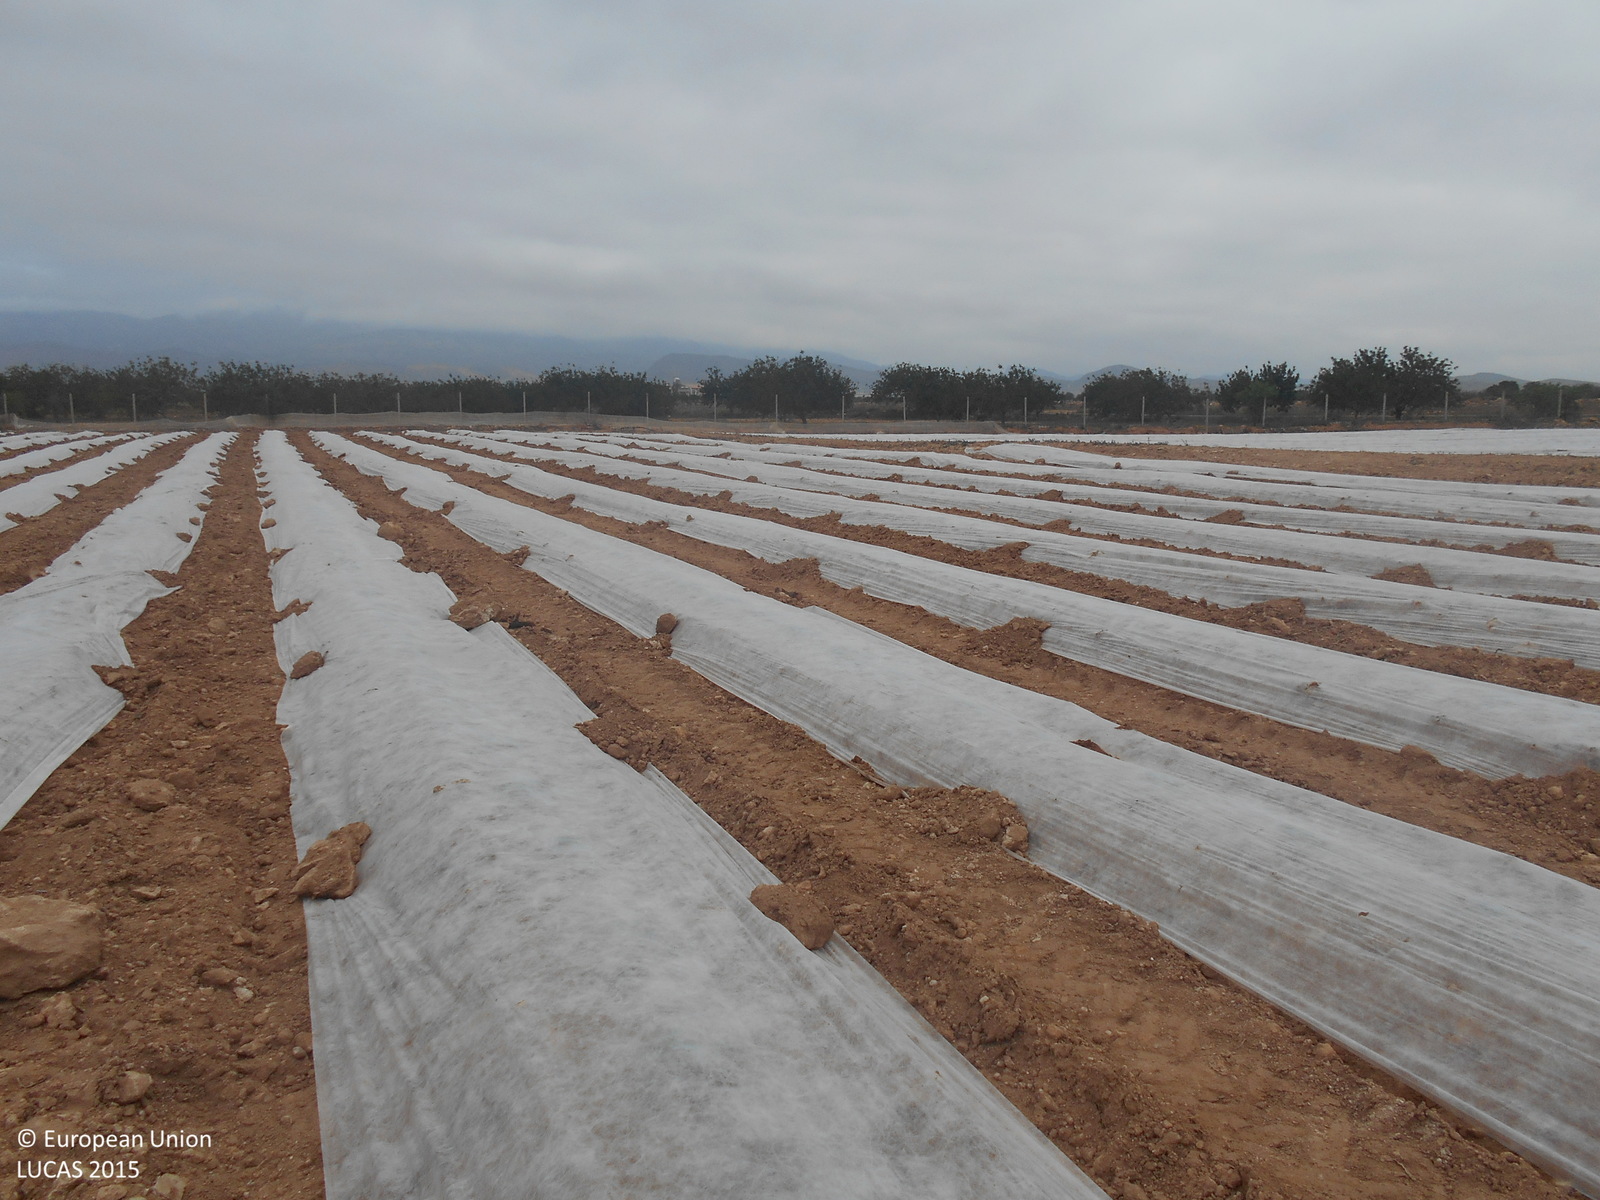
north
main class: Cropland
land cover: Other fresh vegetables
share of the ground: < 10 %
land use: Agriculture (excluding fallow land and kitchen gardens)
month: April
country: ES
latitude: 37.7570
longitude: -1.2298
